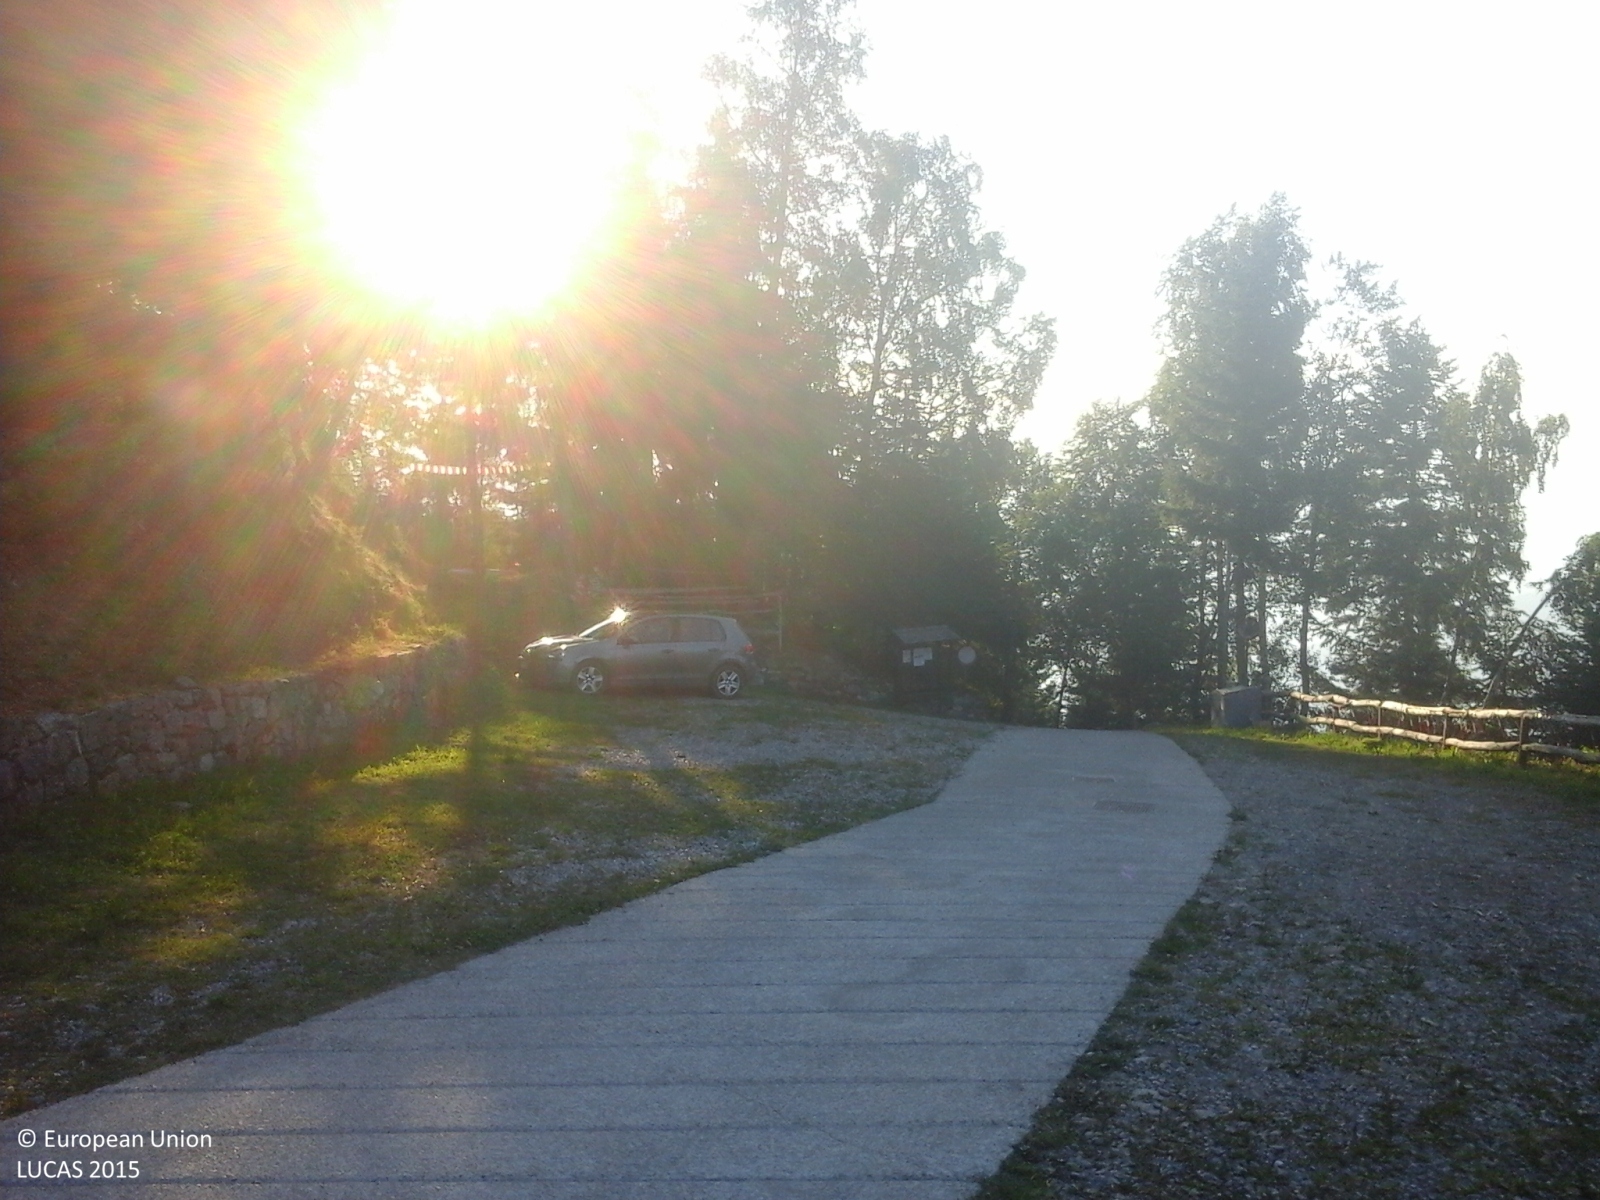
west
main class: Woodland
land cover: Spruce dominated coniferous woodland
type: alpine coniferous forest
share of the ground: > 75 %
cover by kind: coniferous forest trees 100 %
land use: Forestry
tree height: > 5 m
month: August
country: IT
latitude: 46.1158
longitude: 9.4961
